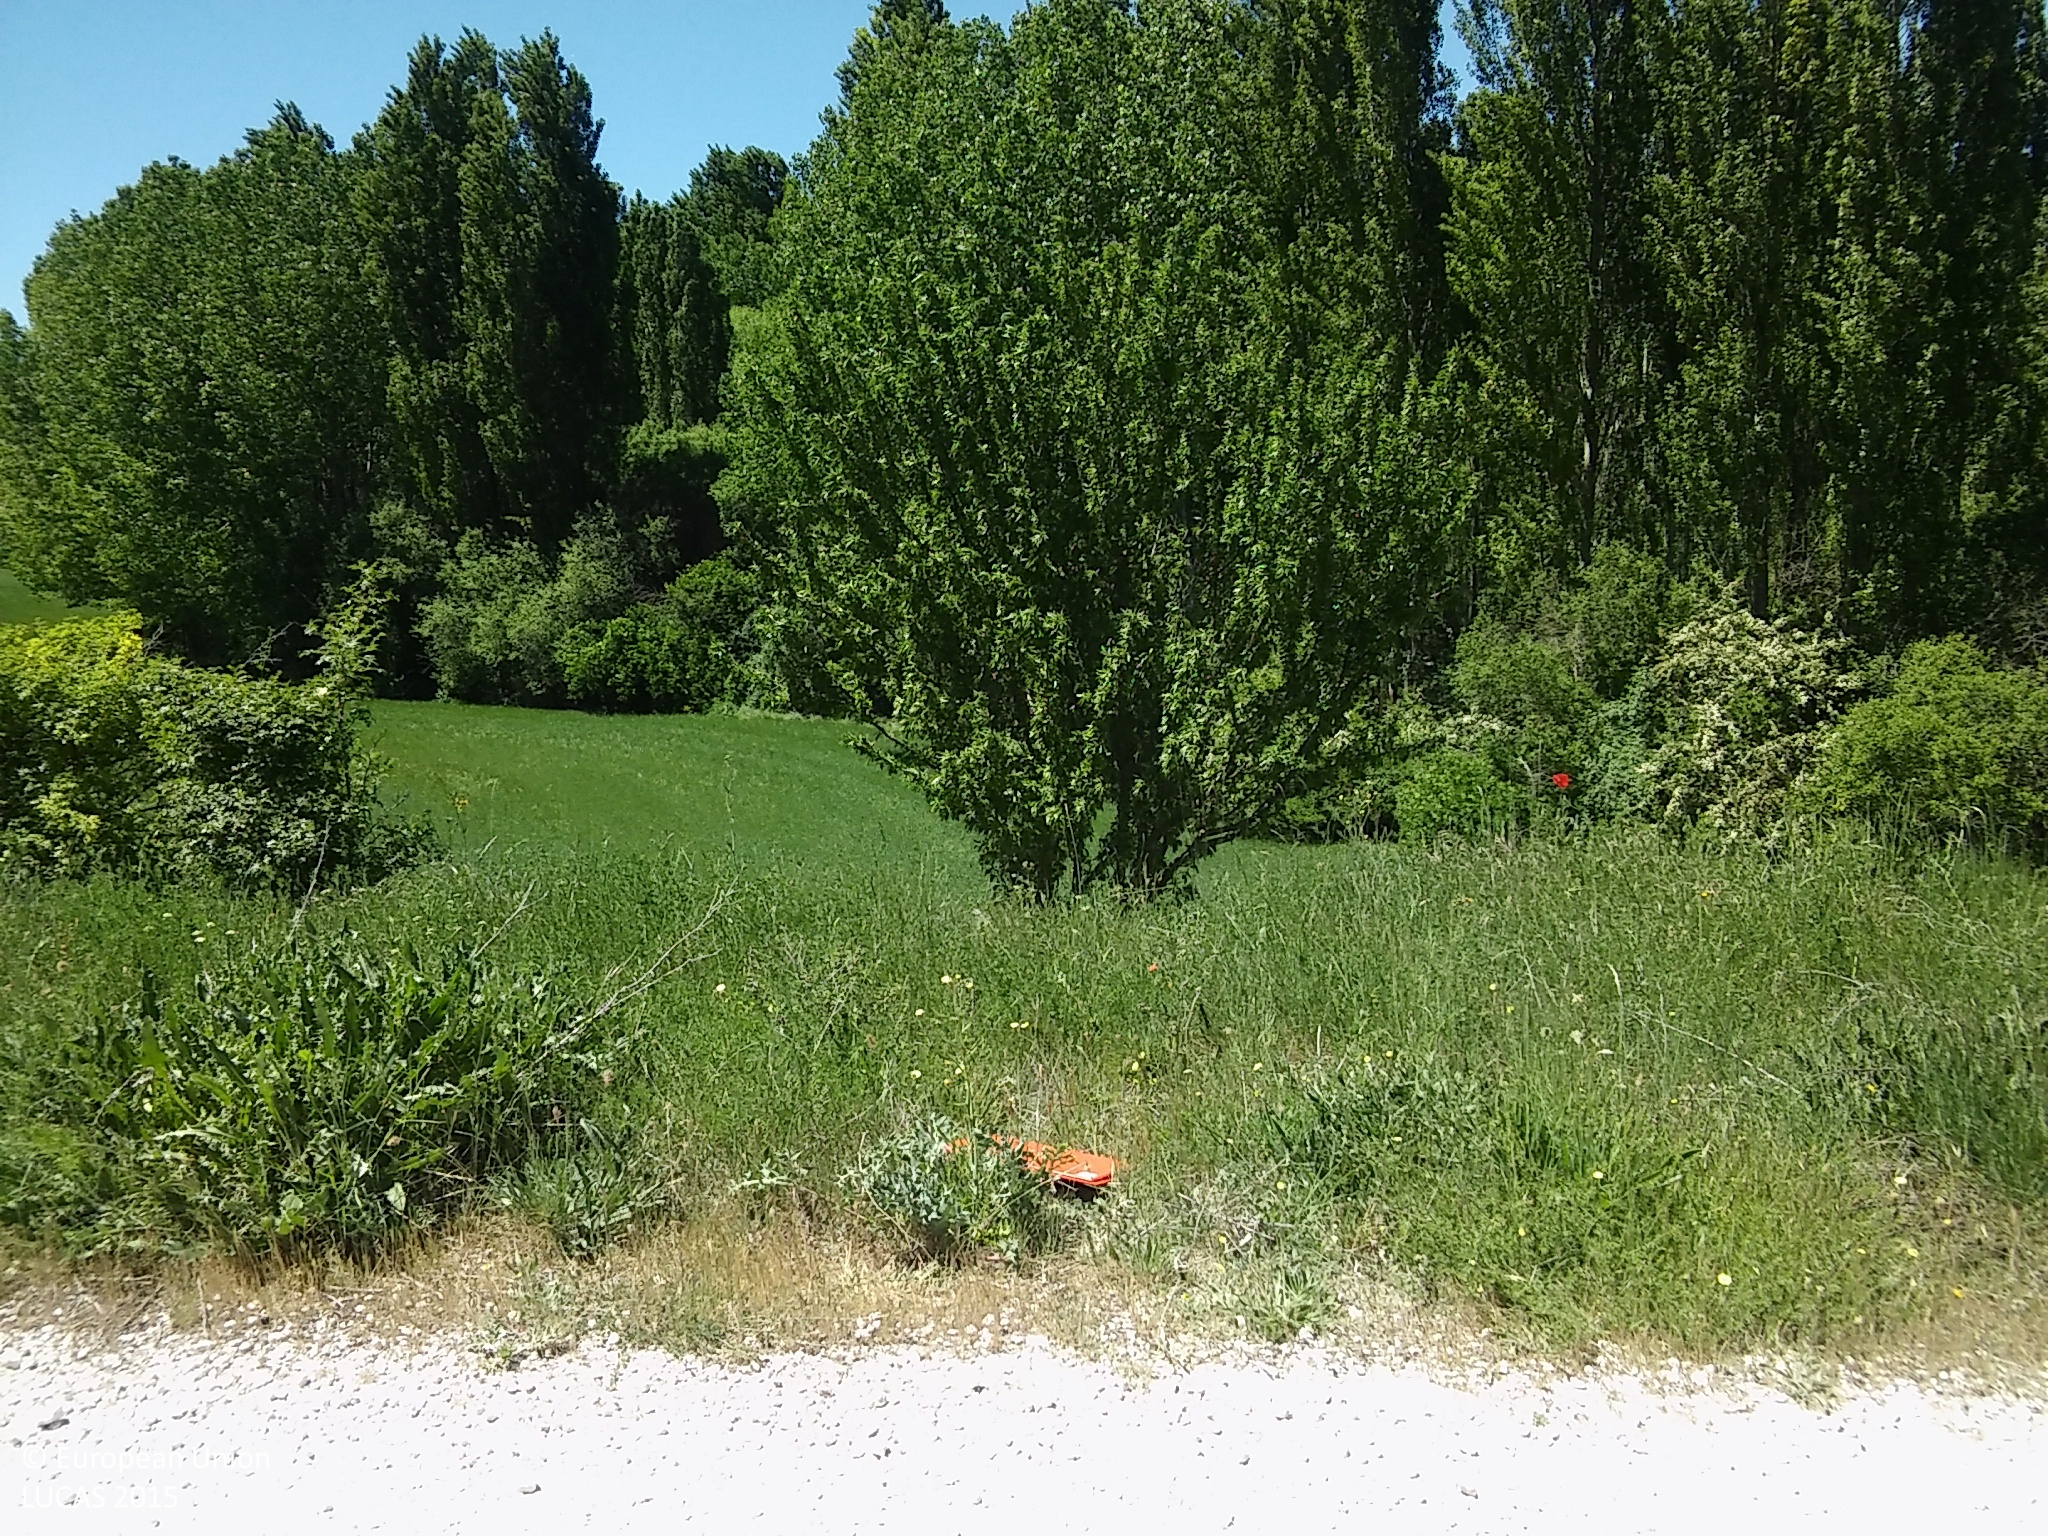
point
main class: Grassland
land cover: Grassland without tree/shrub cover
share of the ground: > 75 %
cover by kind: herbaceous plants 90 %, shrubs 5 %, unconsolidated bare surface 5 %
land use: Semi-natural and natural areas not in use
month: May
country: ES
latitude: 41.4851
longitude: -4.0569
